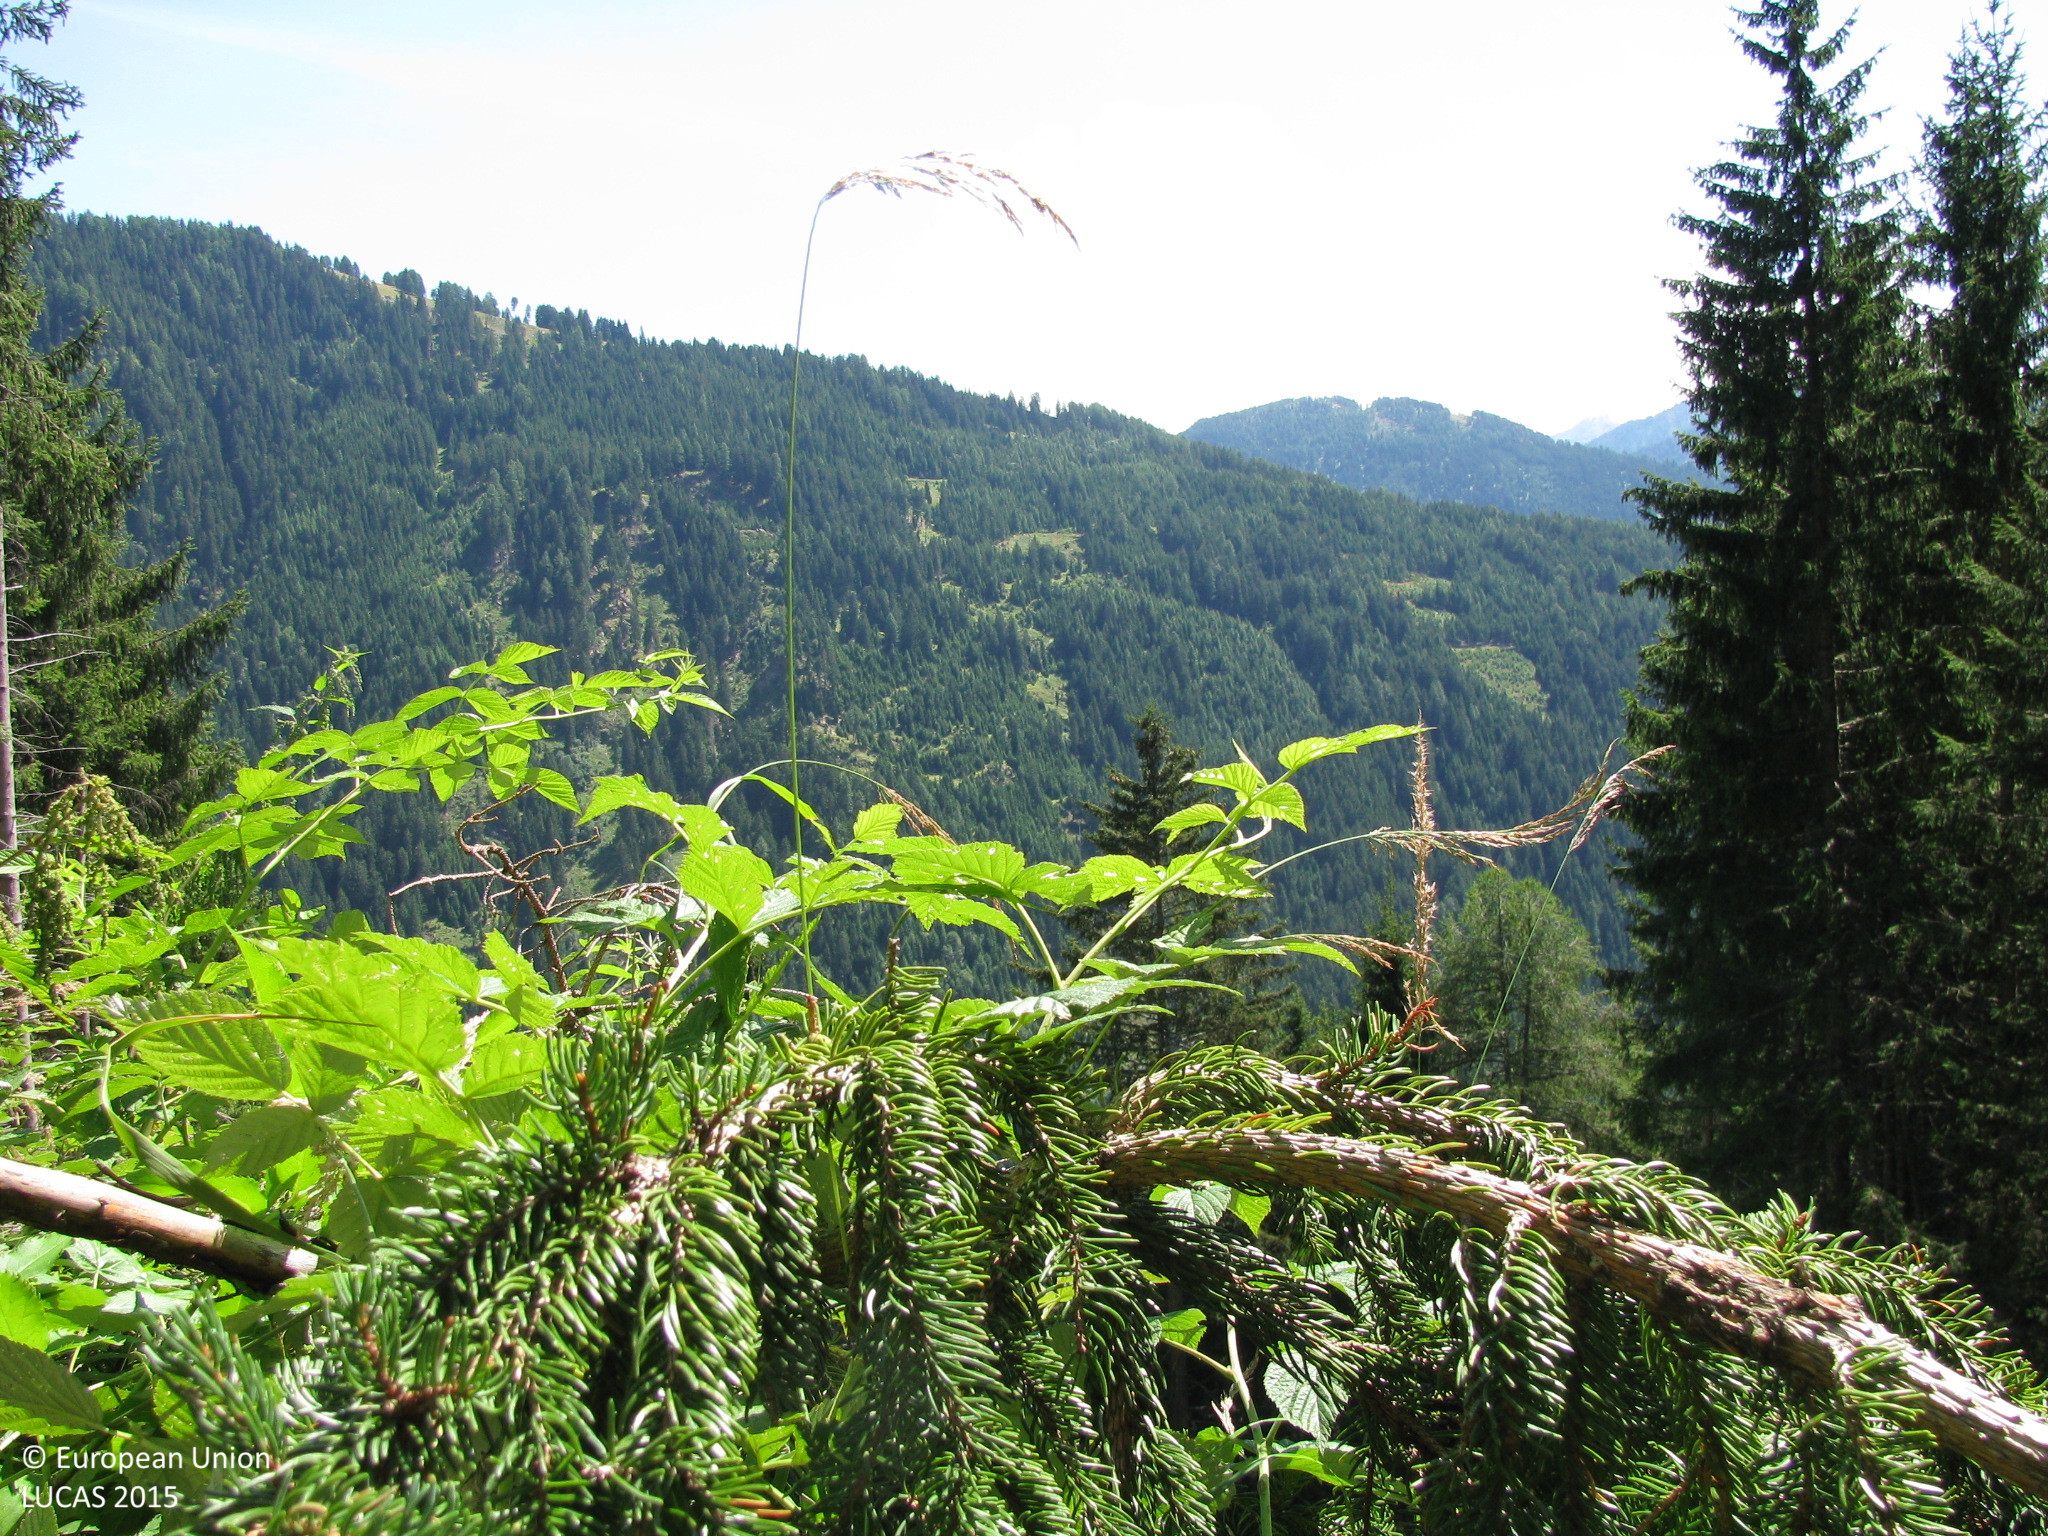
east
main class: Shrubland
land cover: Shrubland with sparse tree cover
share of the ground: > 75 %
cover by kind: shrubs 70 %, herbaceous plants 25 %, coniferous forest trees 5 %
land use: Forestry
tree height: < 5 m
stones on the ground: 25 - 50 %
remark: Clear cut
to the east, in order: Shrubland with sparse tree cover; Spruce dominated coniferous woodland; Spontaneously vegetated surfaces; Spruce dominated coniferous woodland
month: July
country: AT
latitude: 46.8547
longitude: 12.8174
